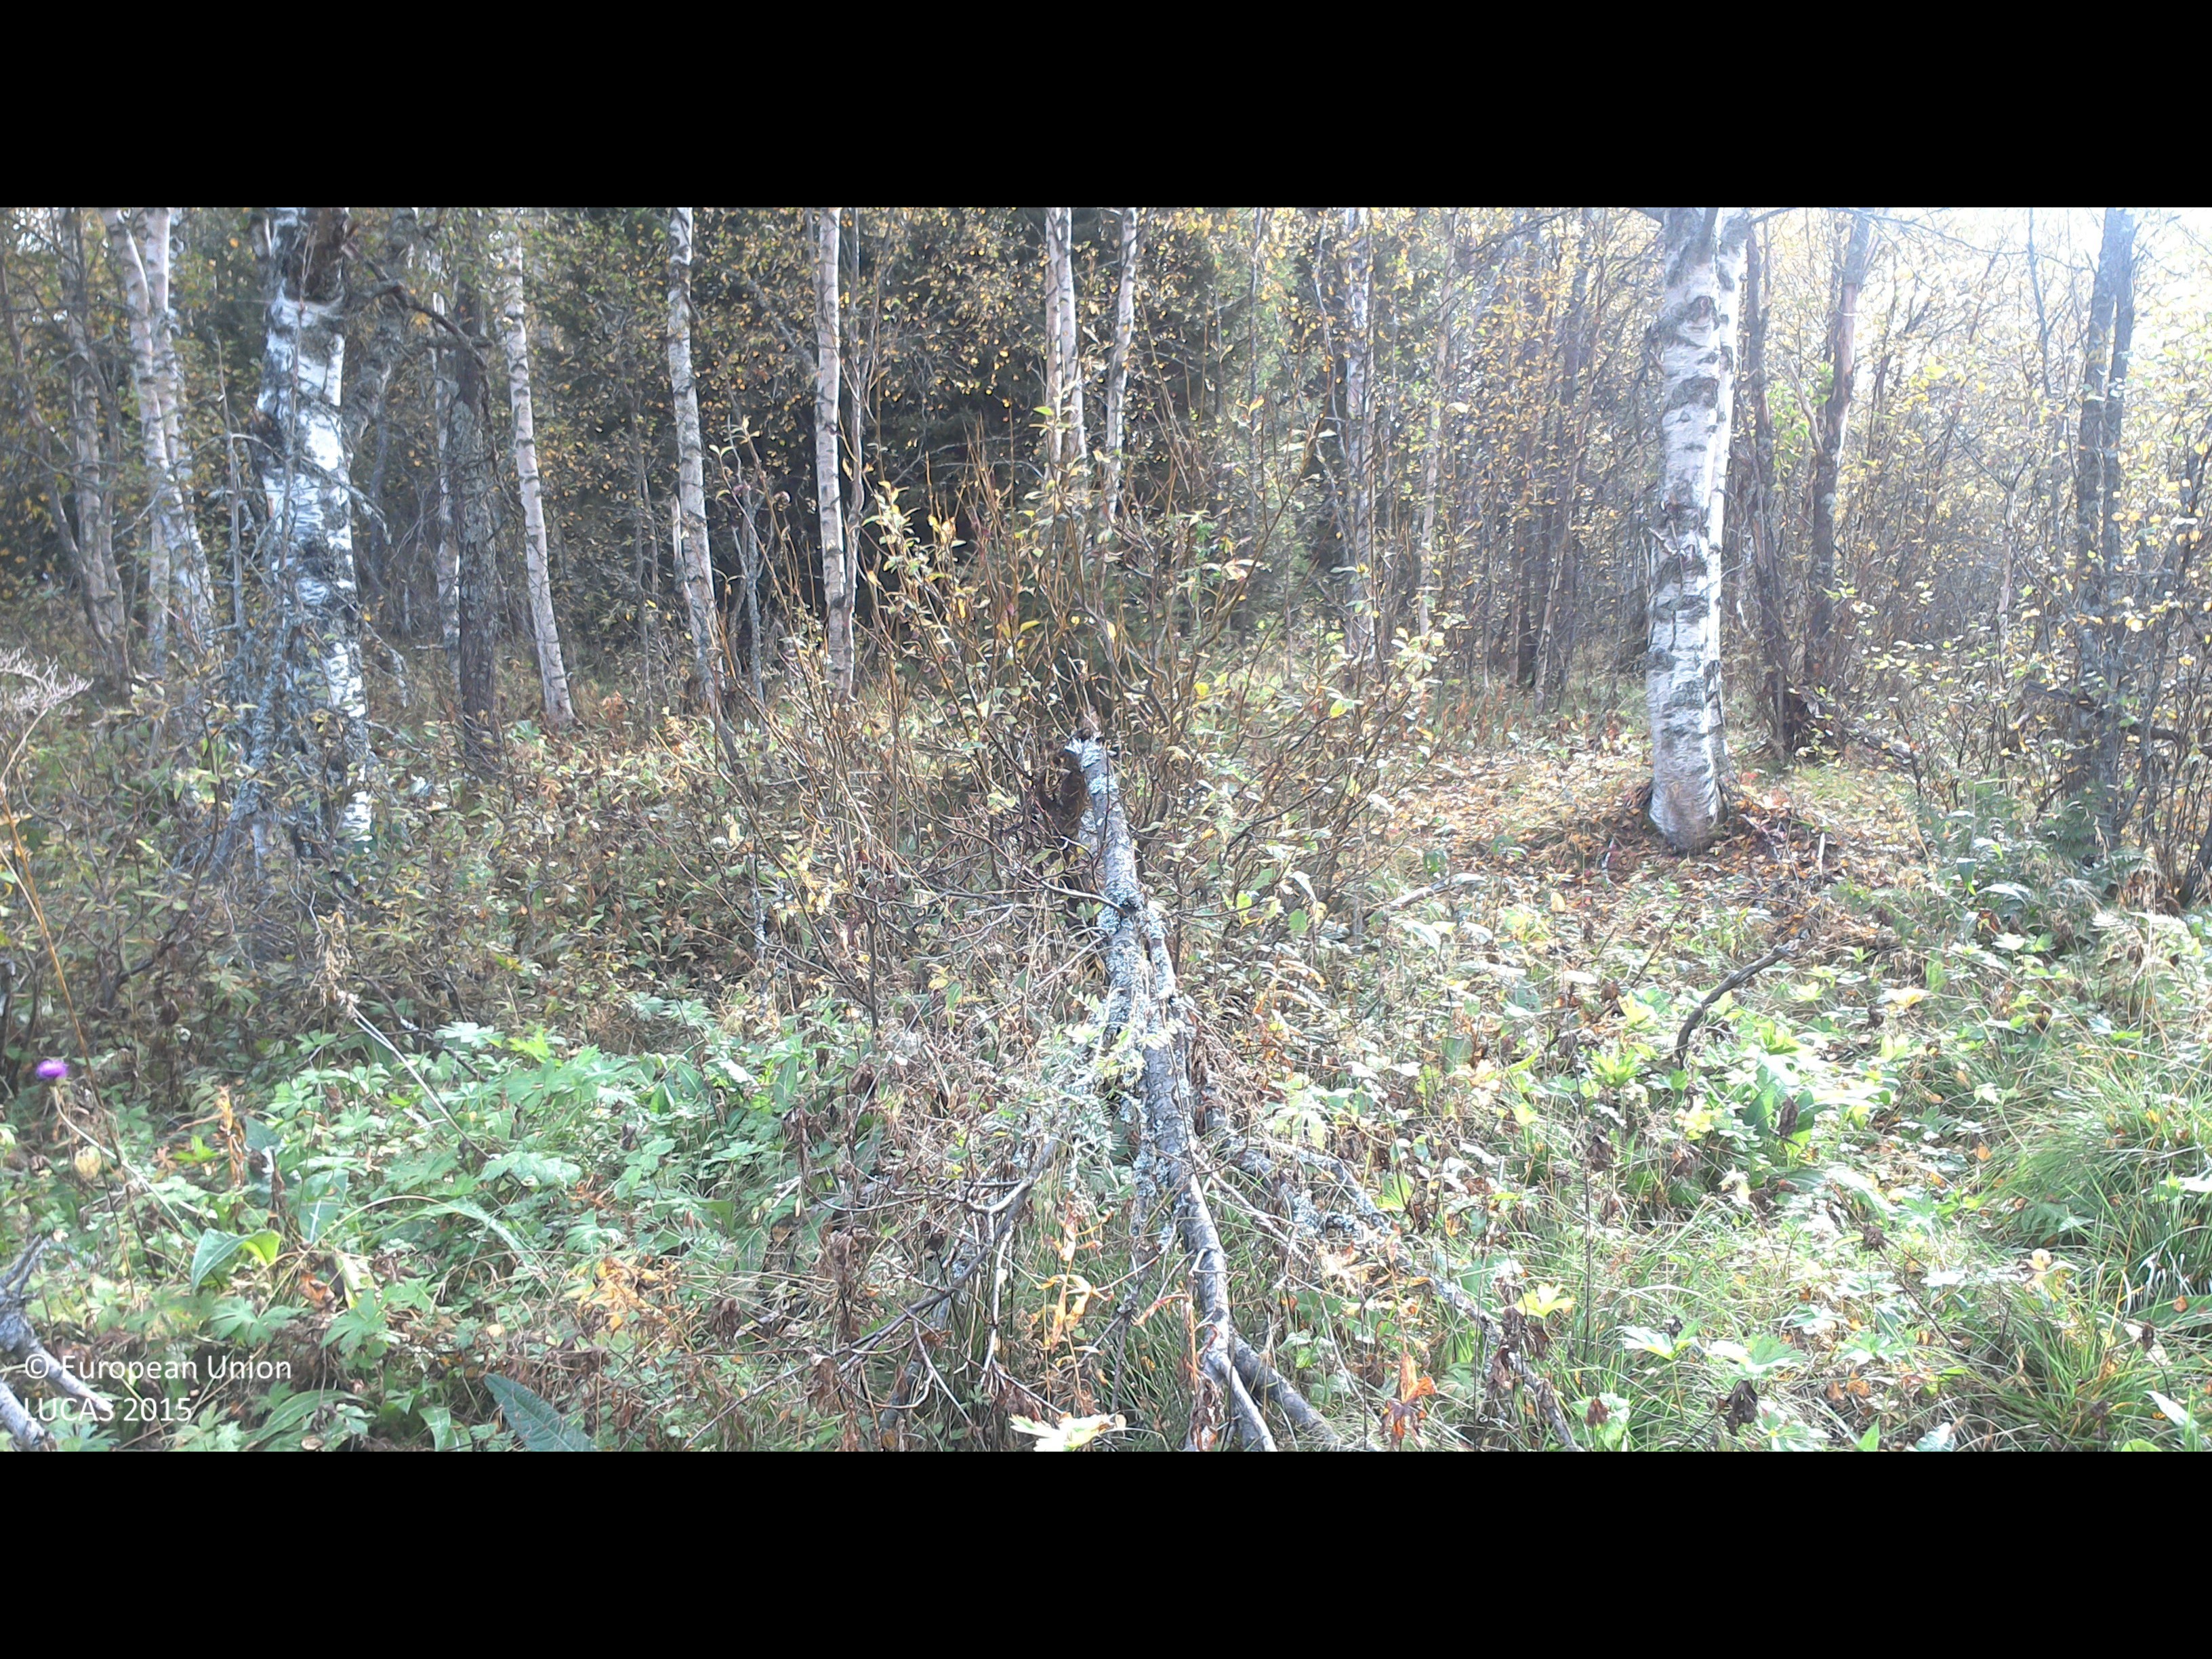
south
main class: Woodland
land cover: Broadleaved woodland
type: hemiboreal forest and nemoral coniferous forest and mixed broadleaved-coniferous forest
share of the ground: 25 - 50 %
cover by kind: broadleaved forest trees 50 %, shrubs 50 %
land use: Semi-natural and natural areas not in use
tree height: > 5 m
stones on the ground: < 10 %
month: September
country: SE
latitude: 63.9186
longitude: 19.9891
